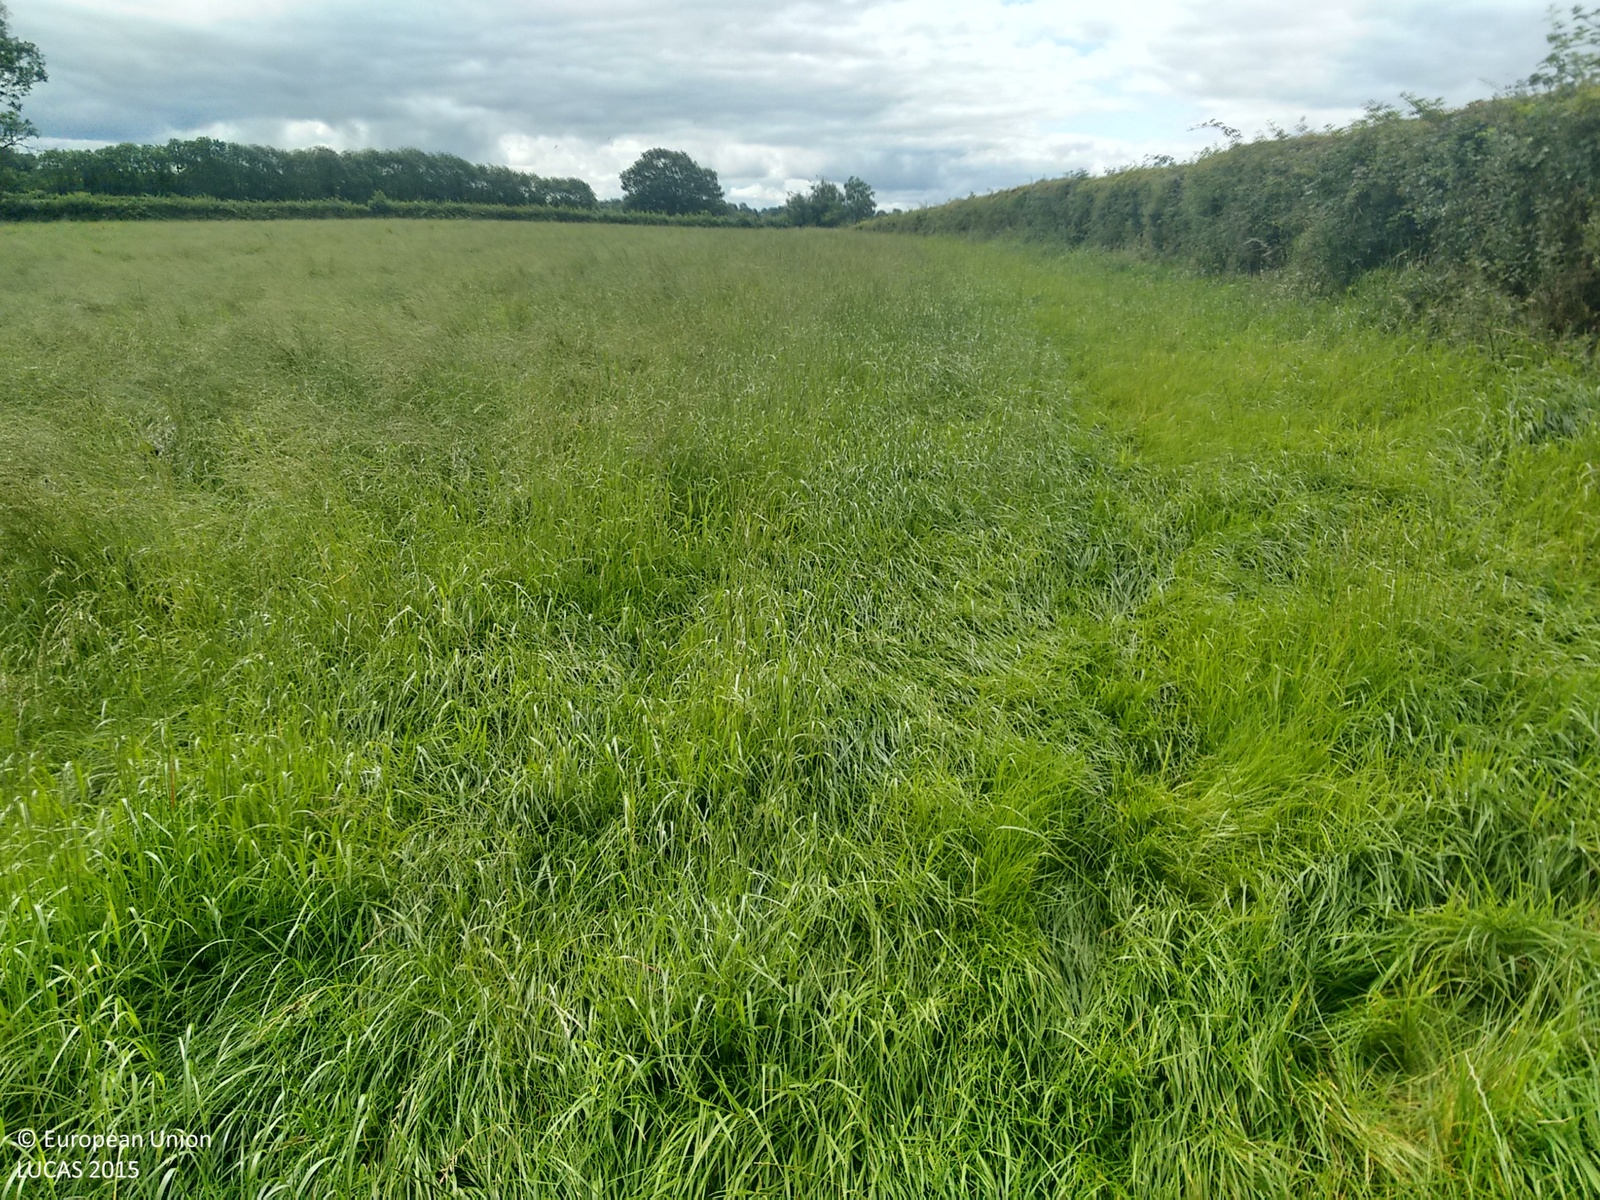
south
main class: Grassland
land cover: Grassland without tree/shrub cover
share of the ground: > 75 %
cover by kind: herbaceous plants 100 %
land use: Agriculture (excluding fallow land and kitchen gardens)
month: August
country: GB
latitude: 54.3114
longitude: -6.8114
